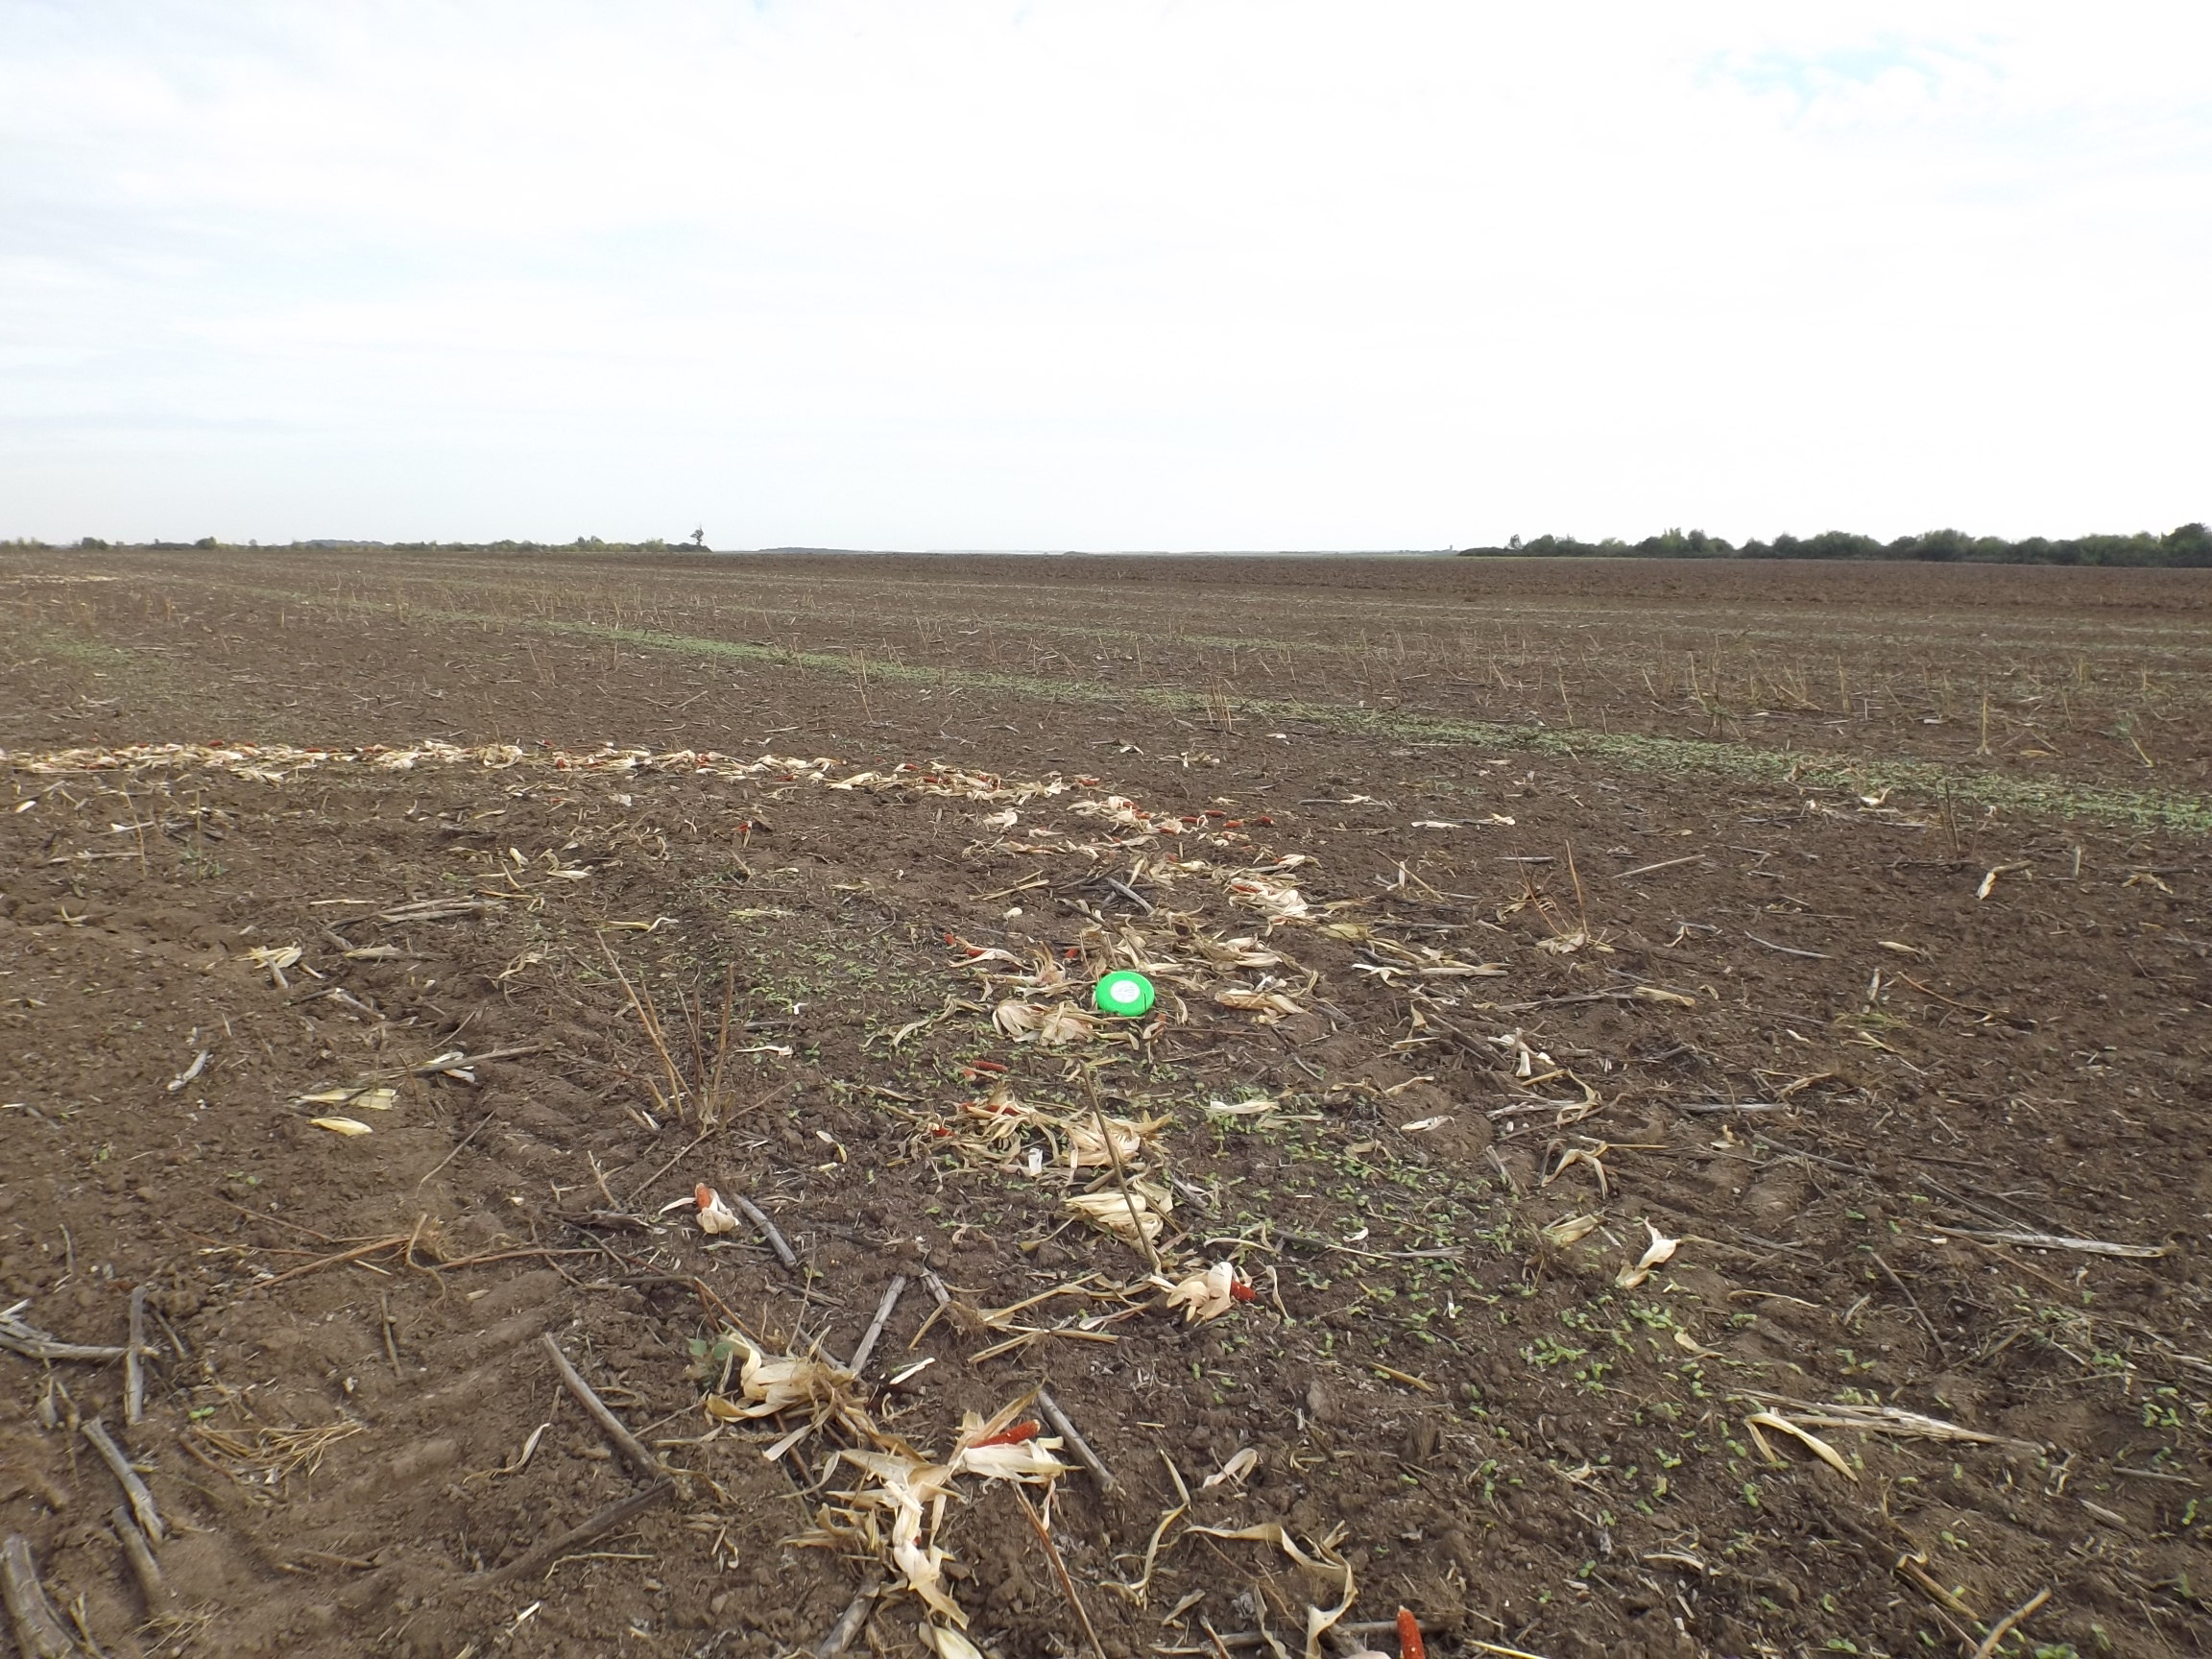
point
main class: Cropland
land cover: Sunflower
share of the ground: < 10 %
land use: Agriculture (excluding fallow land and kitchen gardens)
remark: Harvested field
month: October
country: BG
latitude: 43.9491
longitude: 26.8785
